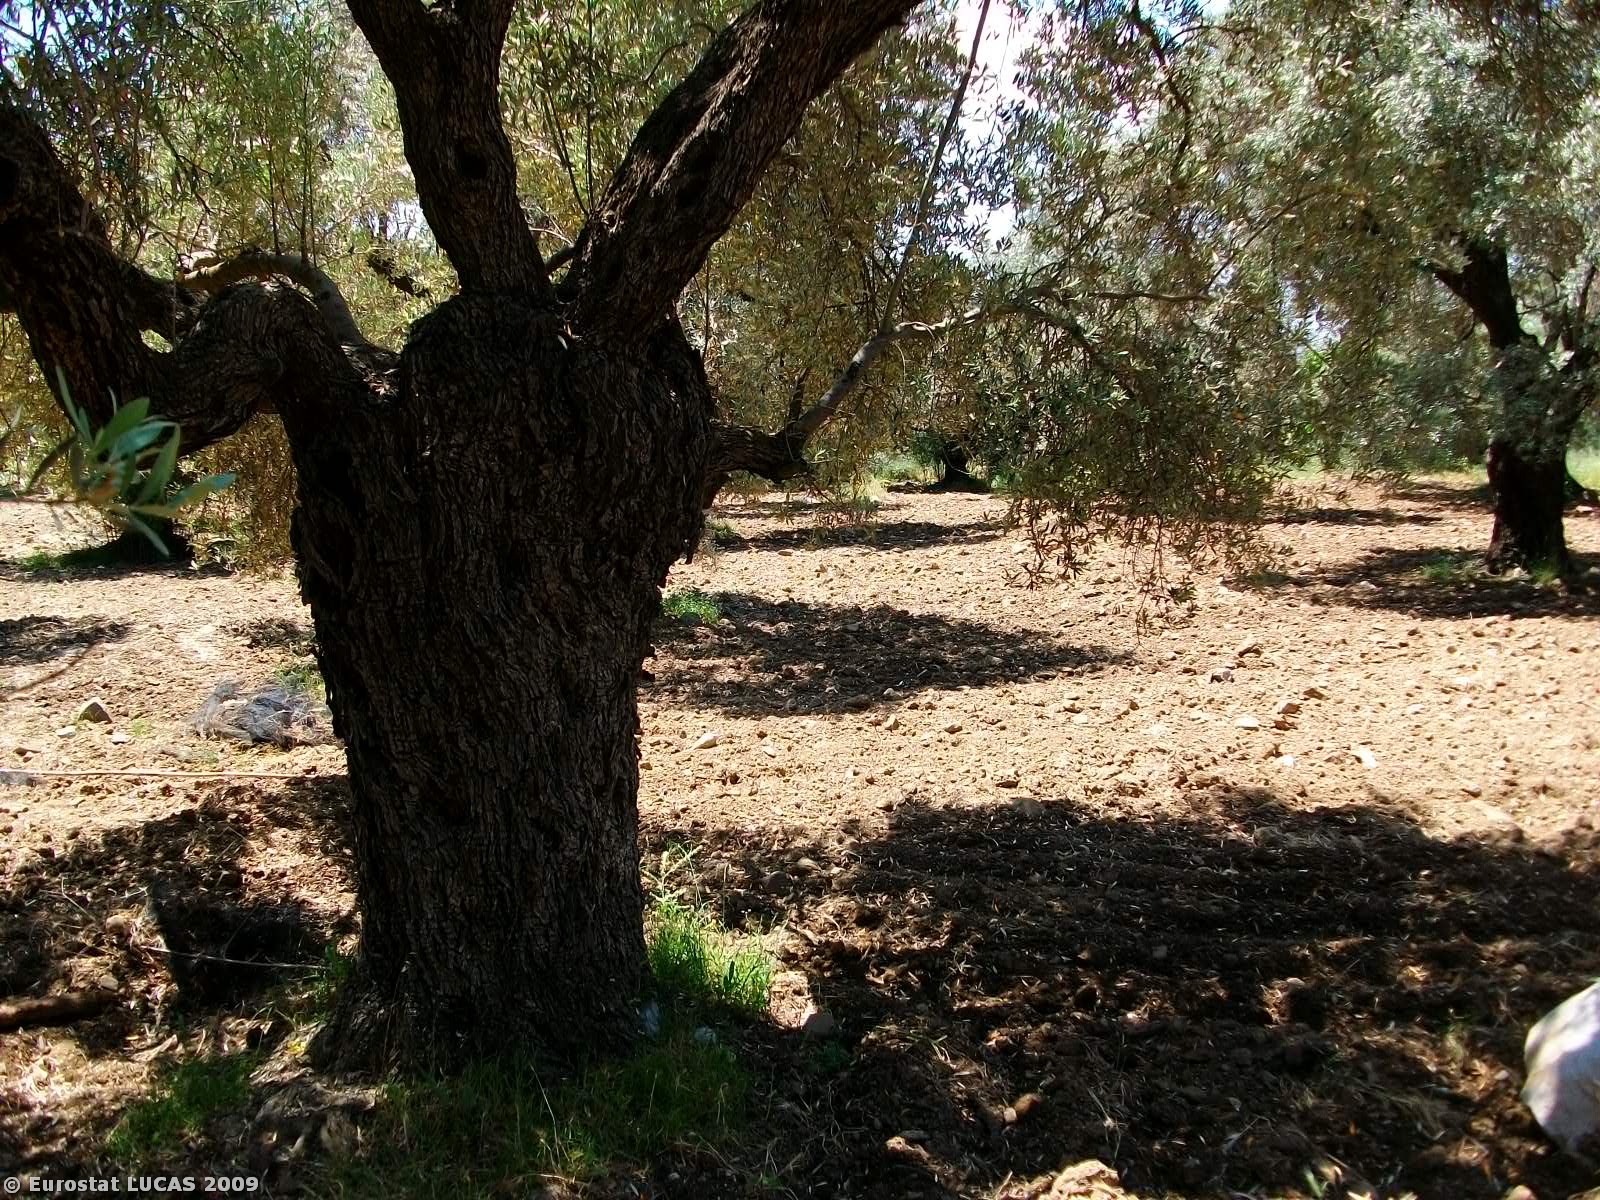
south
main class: Cropland
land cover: Olive groves
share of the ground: > 75 %
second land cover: Bare land
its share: > 75 %
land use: Agriculture (excluding fallow land and kitchen gardens)
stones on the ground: 10 - 25 %
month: May
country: GR
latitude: 35.1368
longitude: 24.9684
